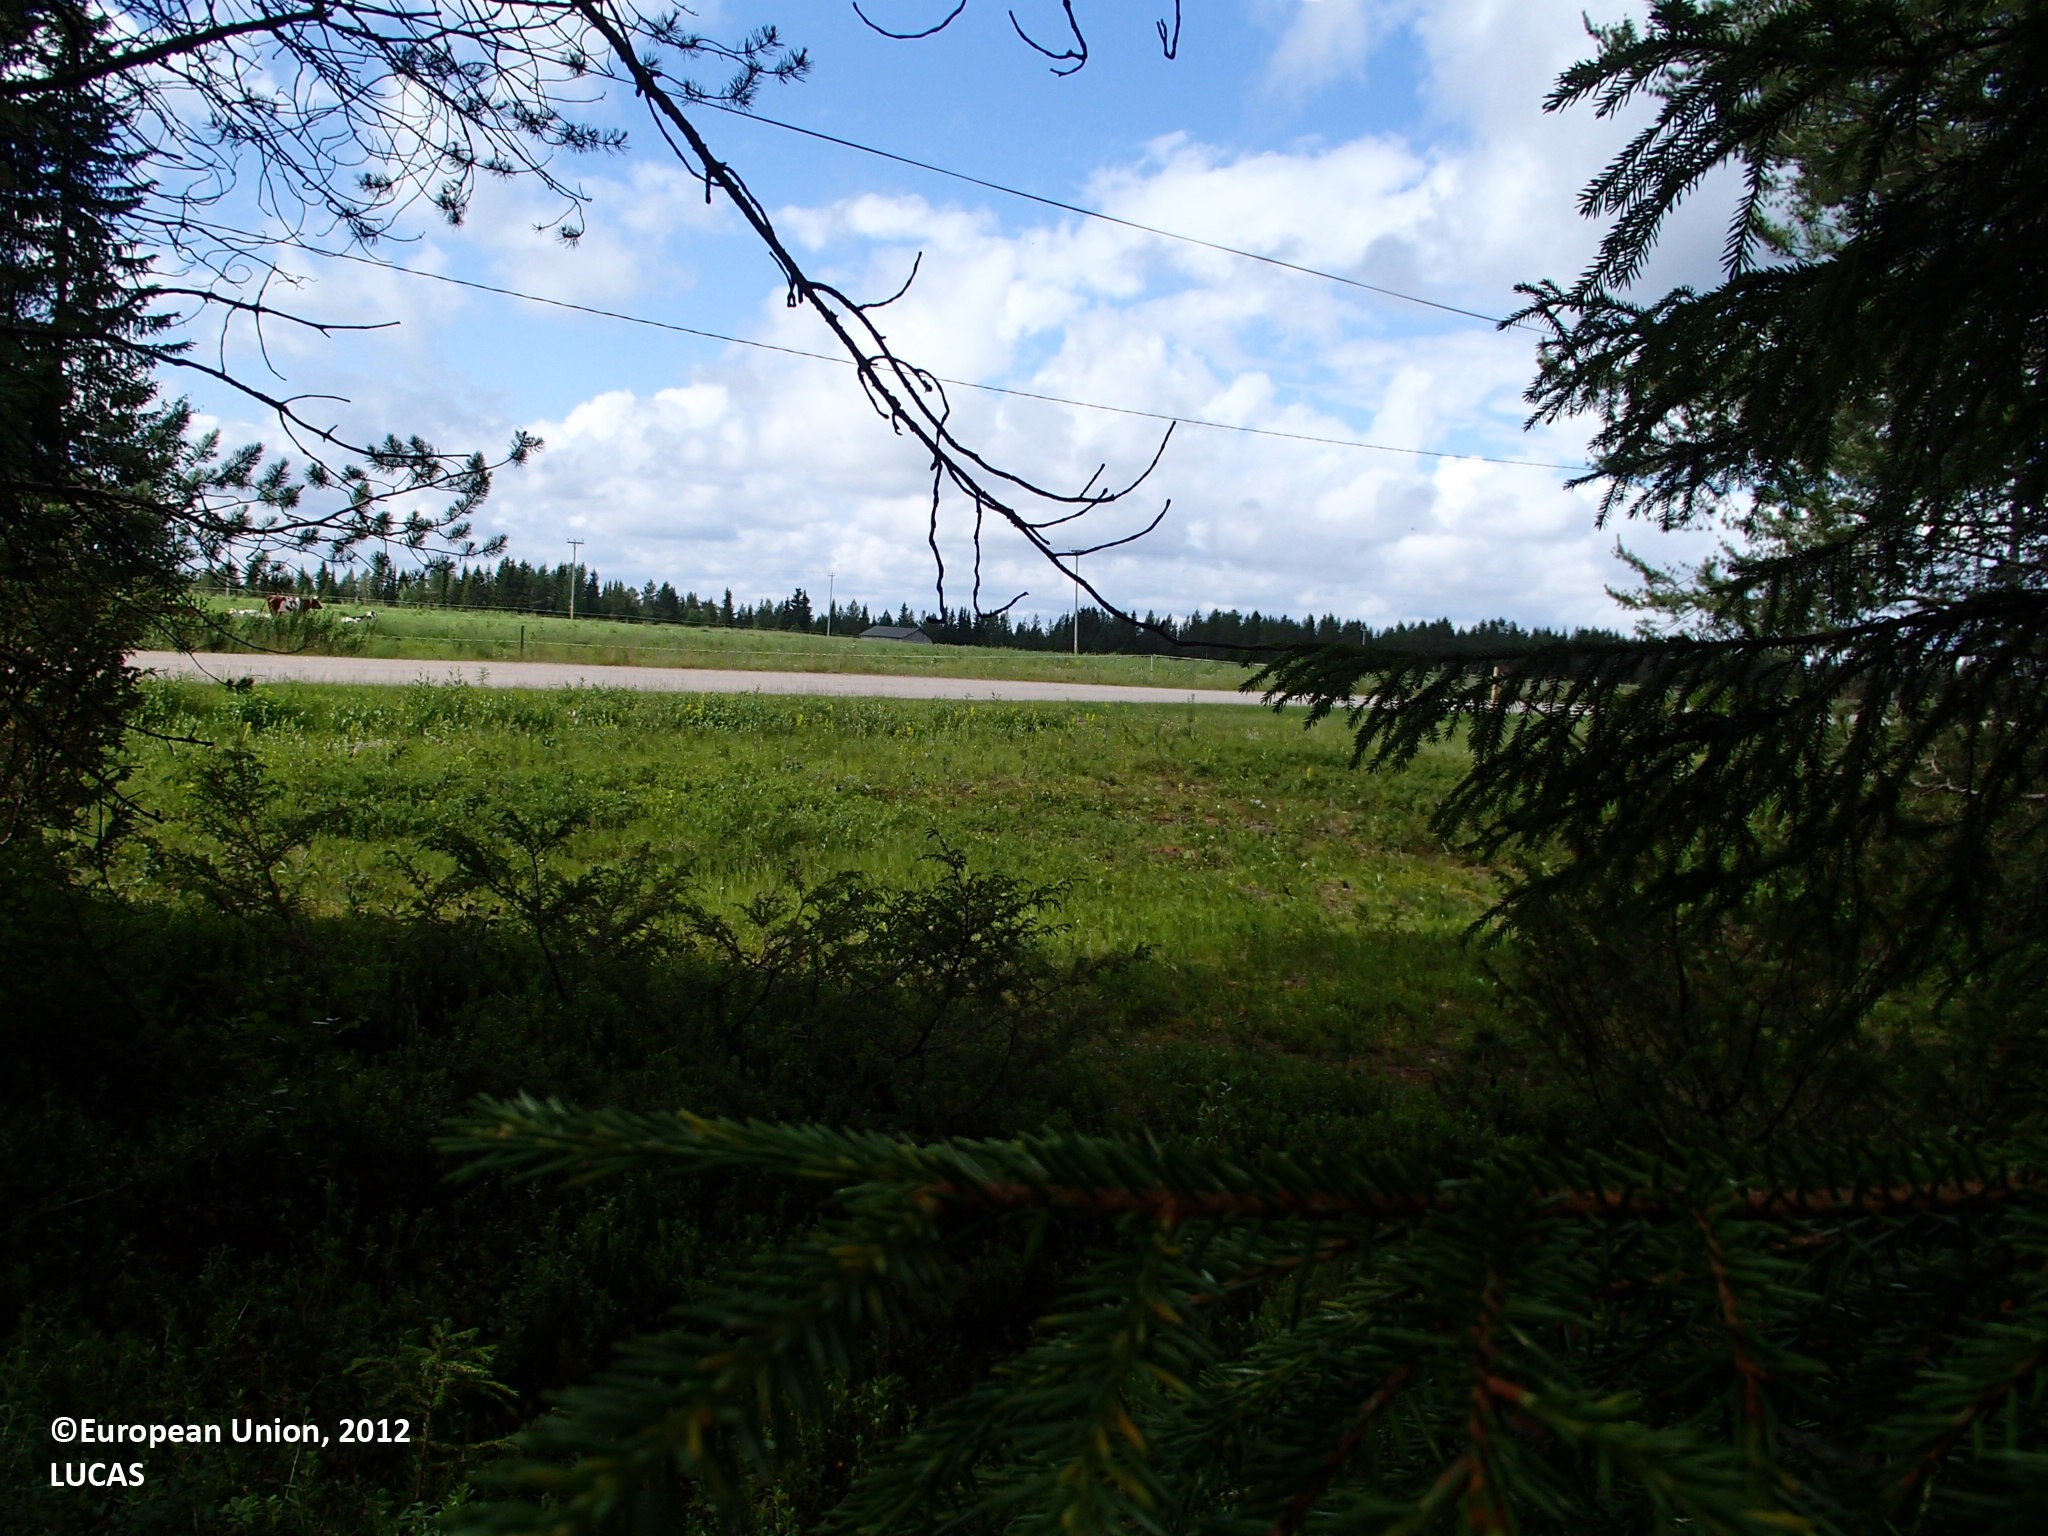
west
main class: Woodland
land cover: Pine dominated coniferous woodland
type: boreal forest
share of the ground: > 75 %
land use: Forestry
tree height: > 5 m
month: July
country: FI
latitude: 67.2762
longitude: 25.5262
